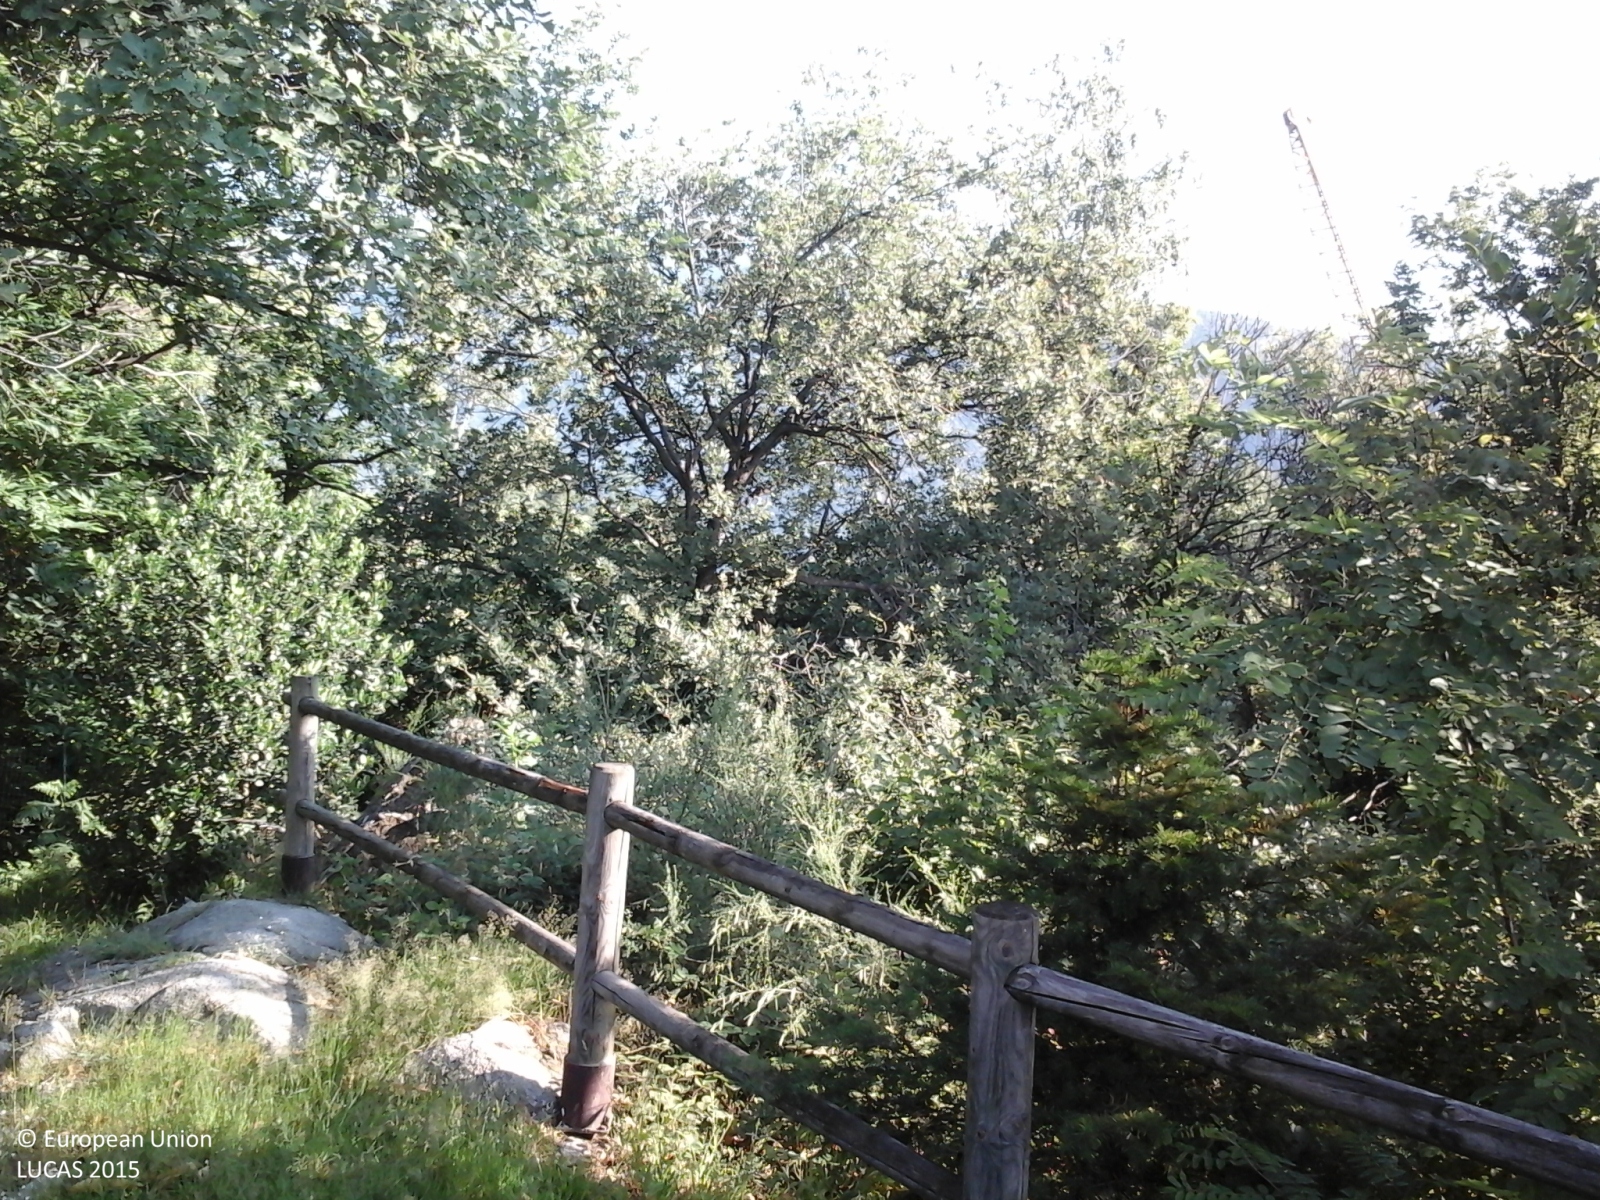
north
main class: Woodland
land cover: Broadleaved woodland
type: mesophytic deciduous forest
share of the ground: > 75 %
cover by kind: broadleaved forest trees 100 %
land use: Forestry
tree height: > 5 m
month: June
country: IT
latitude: 45.9438
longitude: 8.4672
